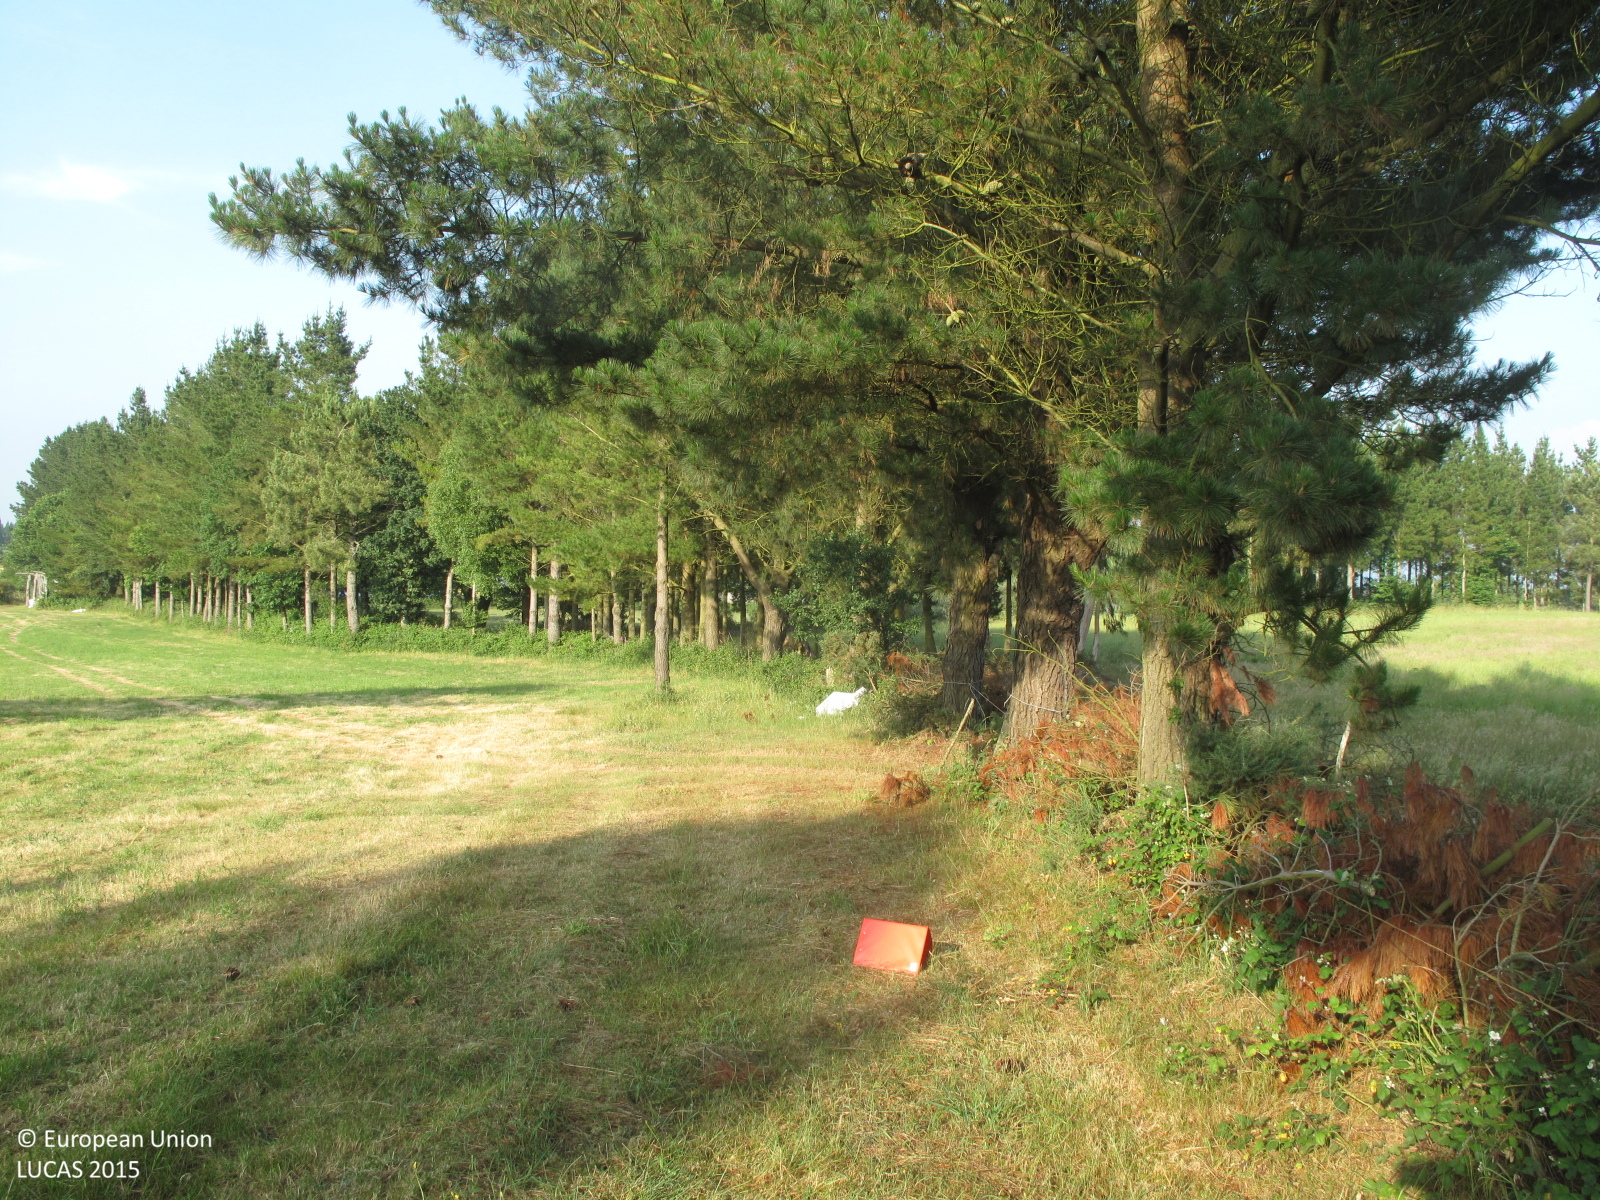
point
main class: Grassland
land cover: Grassland without tree/shrub cover
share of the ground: > 75 %
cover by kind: herbaceous plants 100 %
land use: Agriculture (excluding fallow land and kitchen gardens)
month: June
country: ES
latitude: 43.0764
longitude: -7.8839
